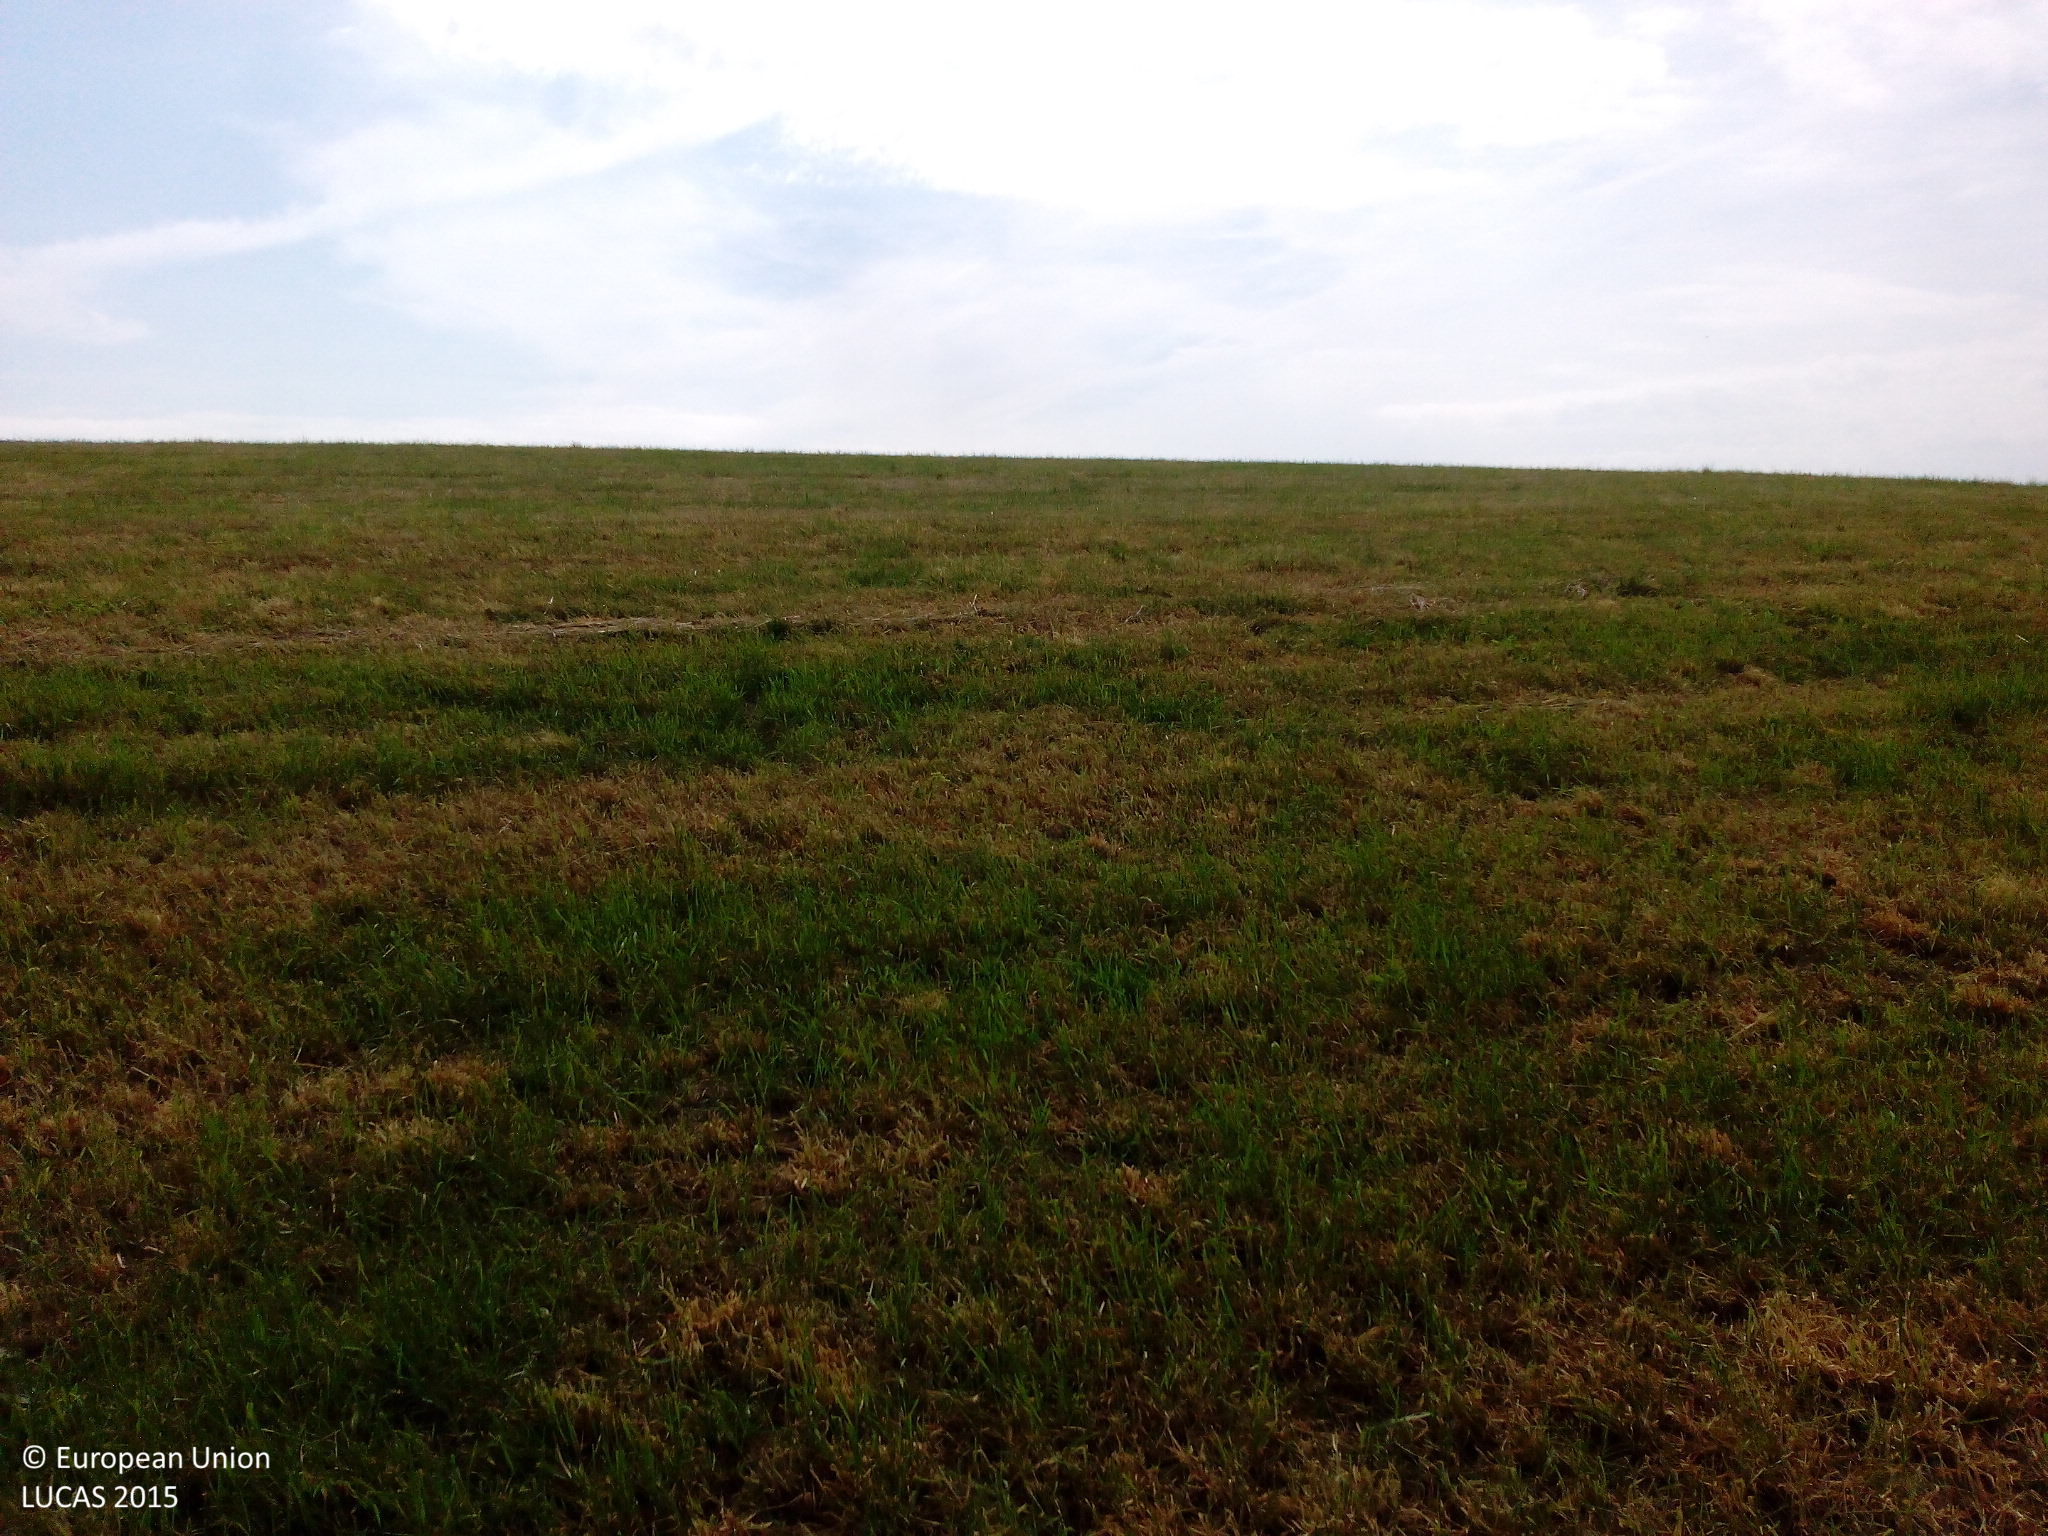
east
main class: Grassland
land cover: Grassland without tree/shrub cover
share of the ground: > 75 %
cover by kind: herbaceous plants 100 %
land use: Agriculture (excluding fallow land and kitchen gardens)
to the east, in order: Grassland without tree/shrub cover; Tracks; Common wheat
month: May
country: DE
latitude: 50.1444
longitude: 10.9373
